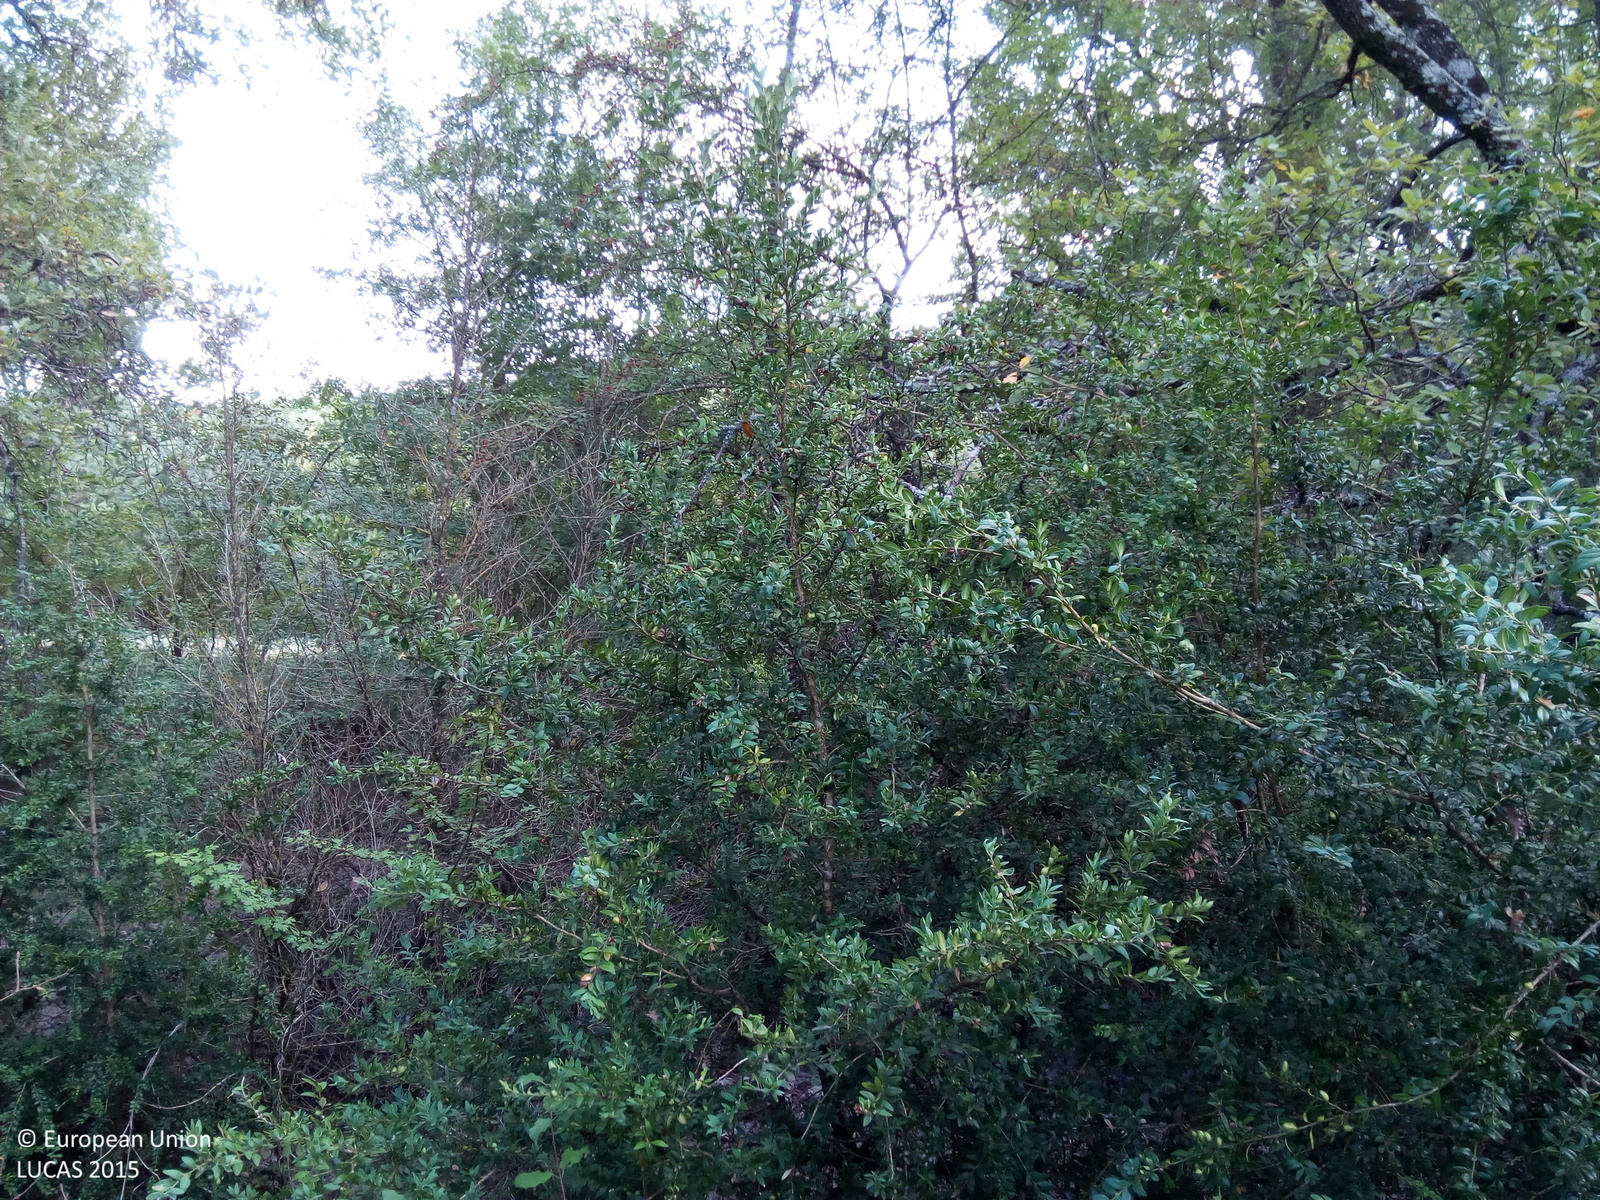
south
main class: Woodland
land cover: Broadleaved woodland
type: broadleaved evergreen forest
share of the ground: > 75 %
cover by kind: broadleaved forest trees 100 %
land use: Semi-natural and natural areas not in use
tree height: > 5 m
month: September
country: ES
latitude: 42.4639
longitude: -0.0316
